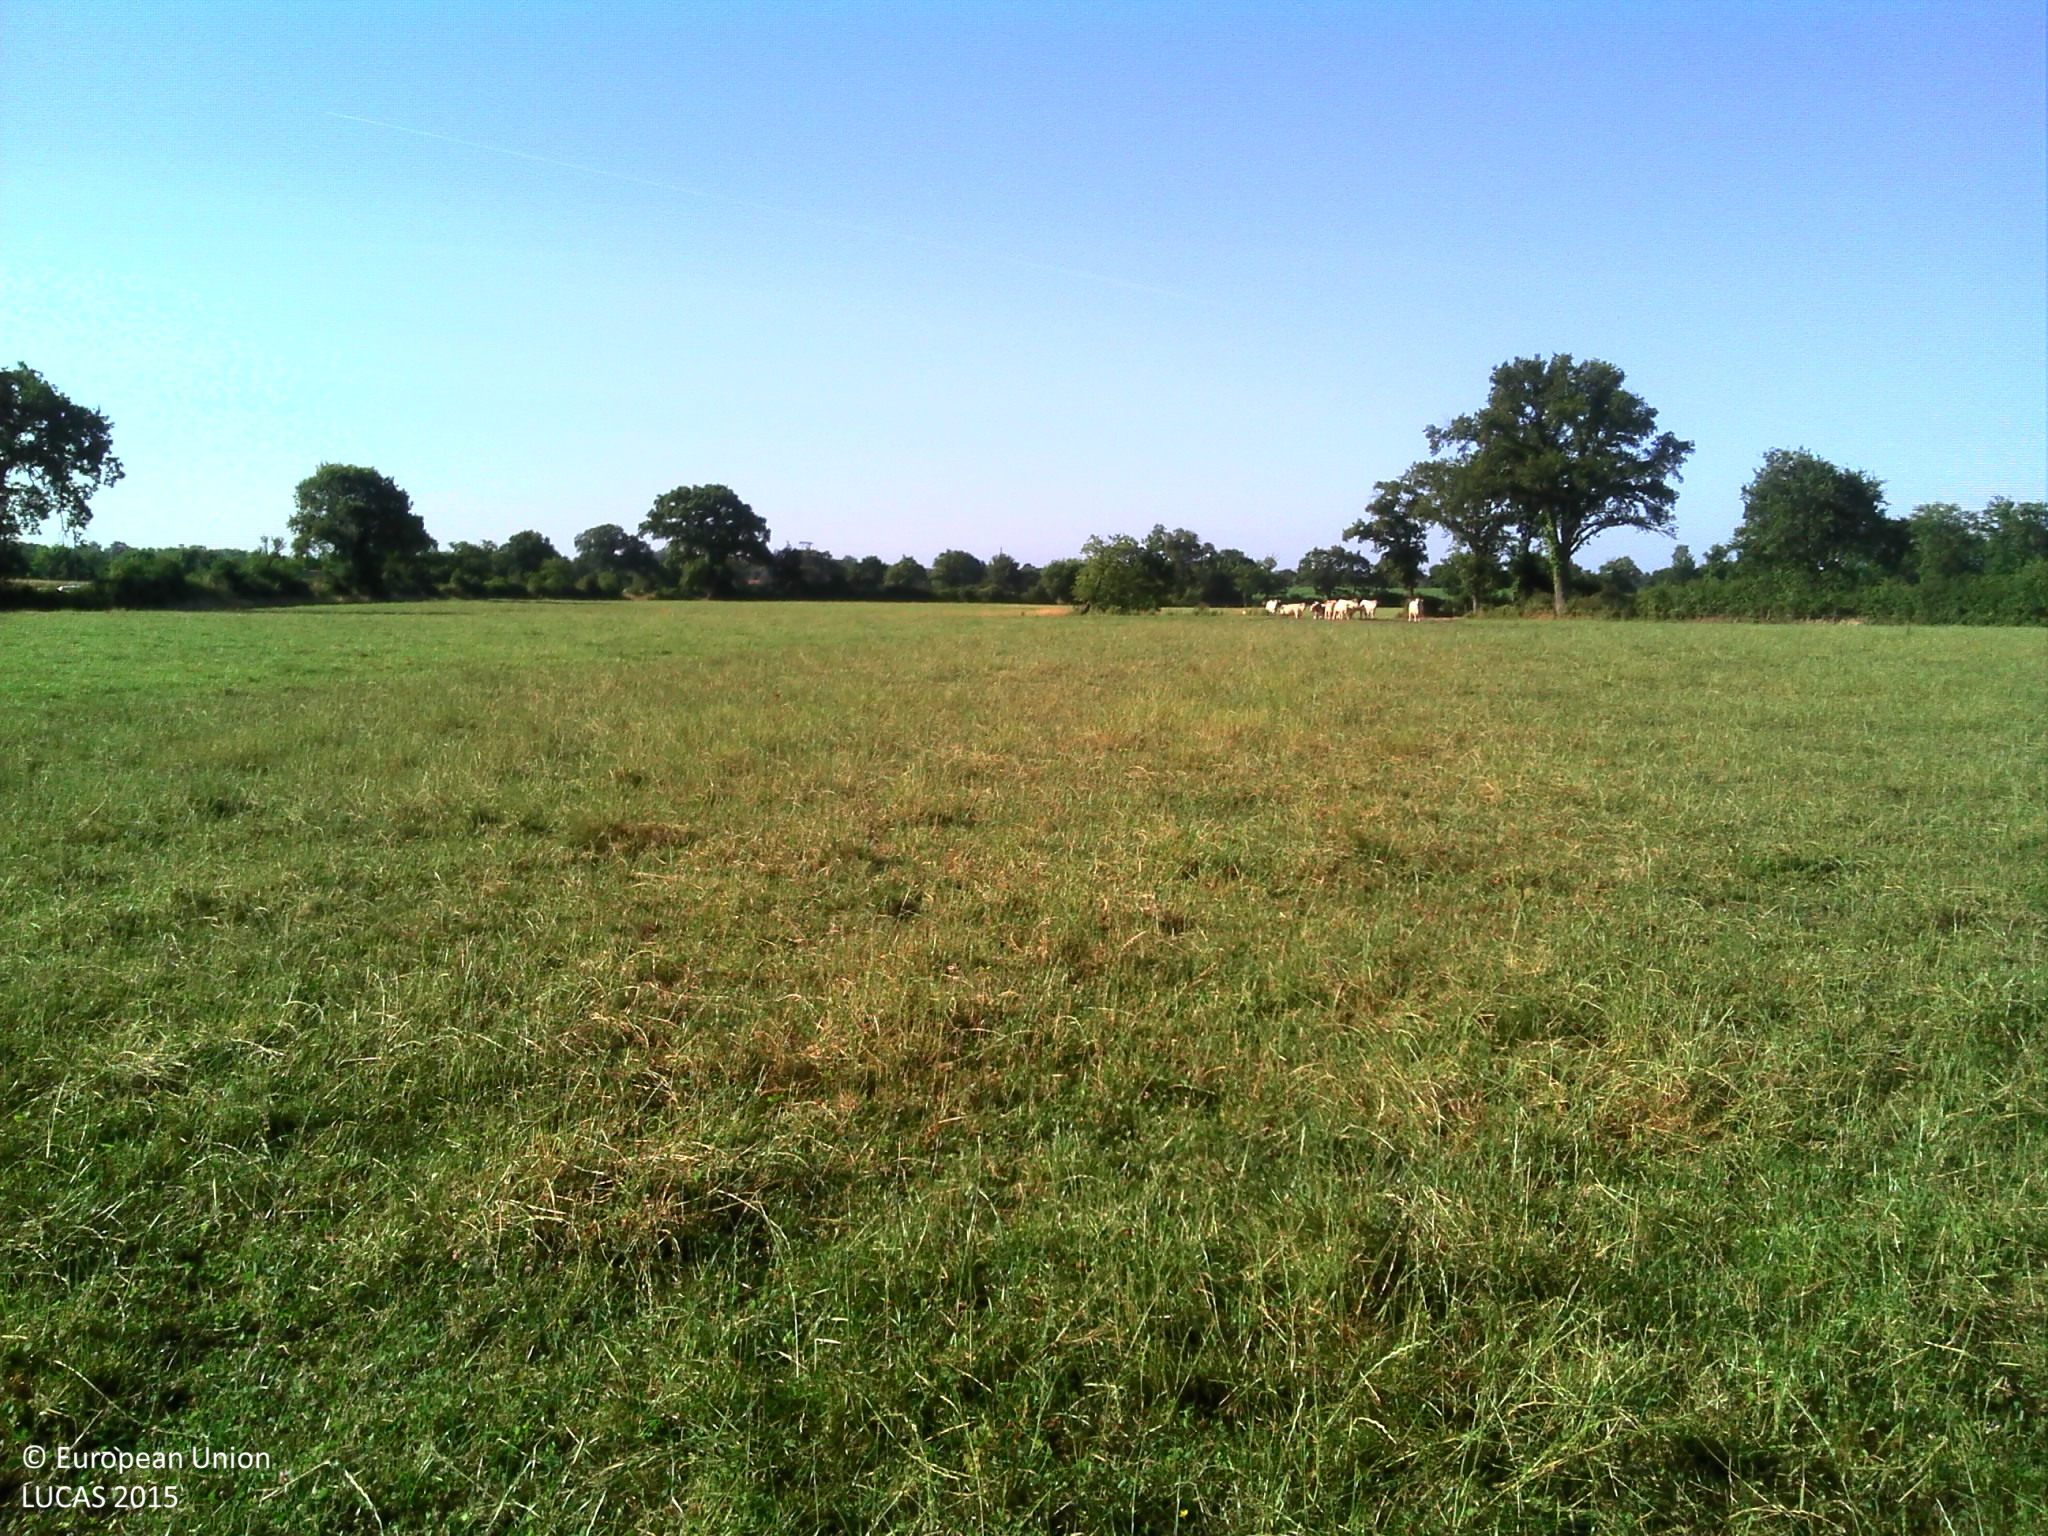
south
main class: Cropland
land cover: Temporary grasslands
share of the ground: > 75 %
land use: Agriculture (excluding fallow land and kitchen gardens)
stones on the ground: < 10 %
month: July
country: FR
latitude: 47.1249
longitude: -1.8700
